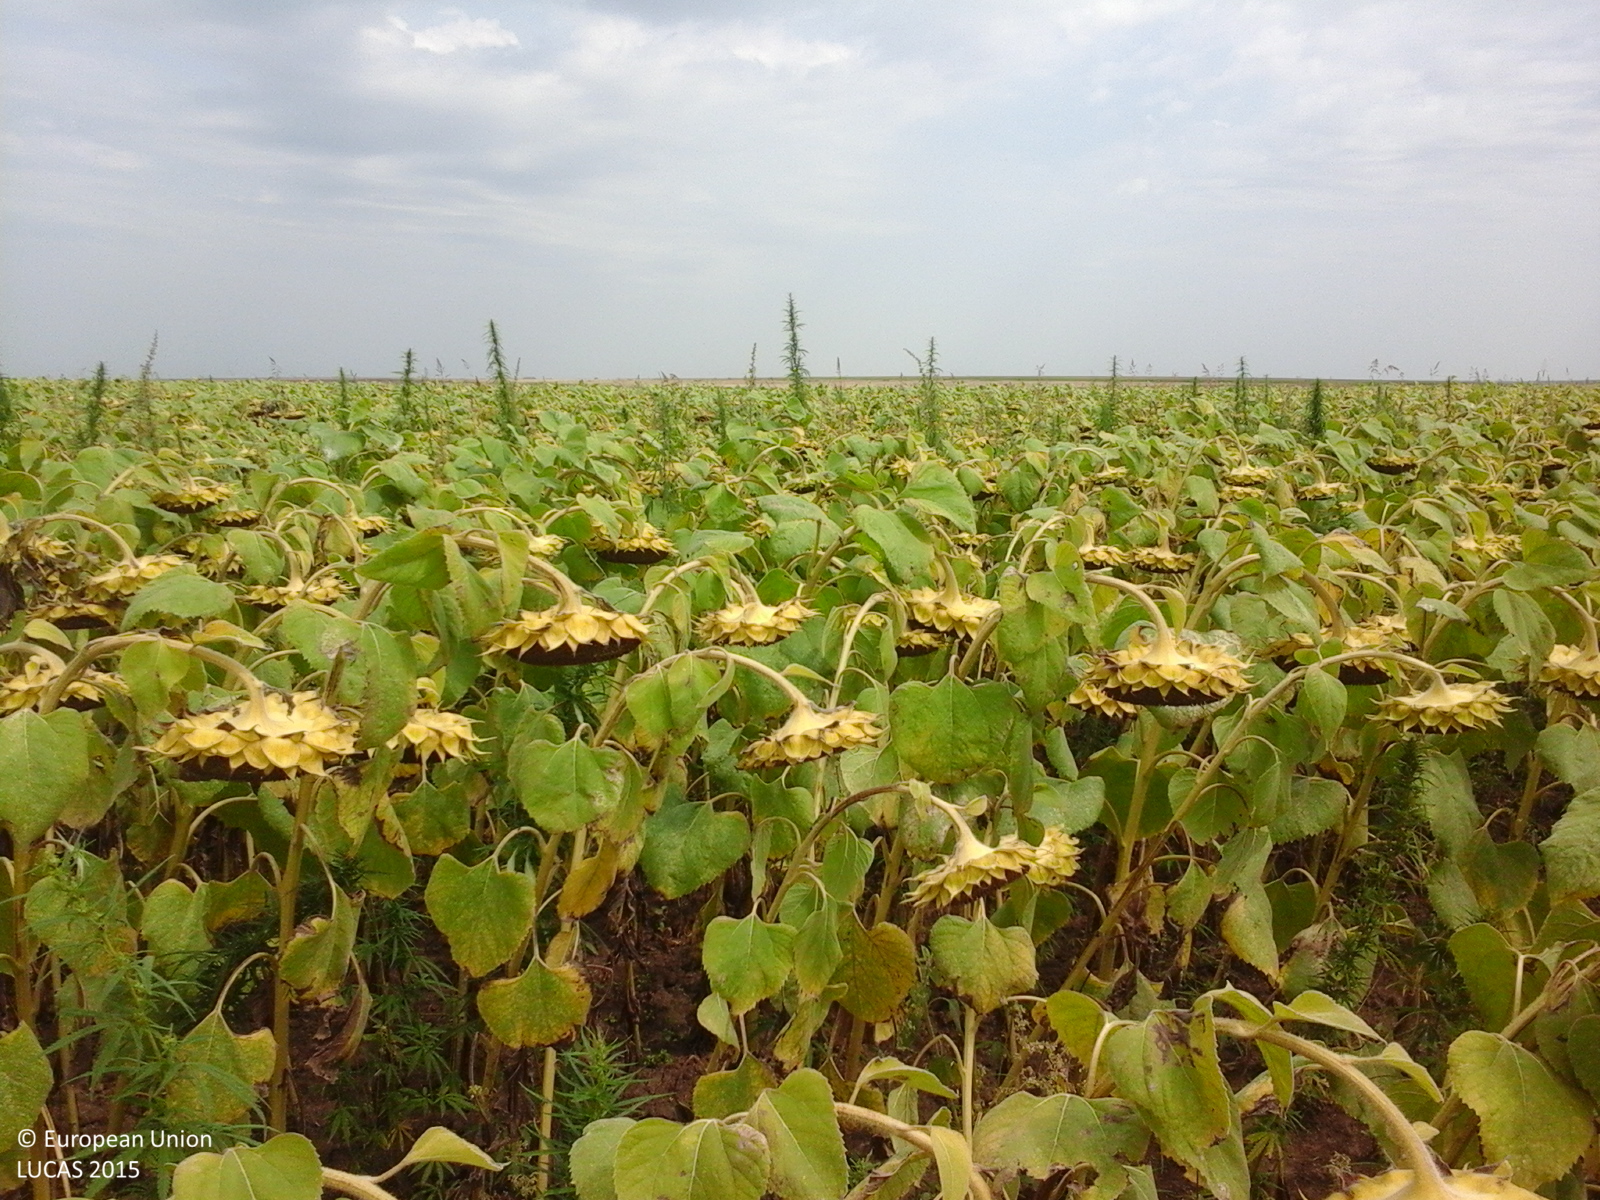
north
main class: Cropland
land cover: Sunflower
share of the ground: > 75 %
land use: Agriculture (excluding fallow land and kitchen gardens)
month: August
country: RO
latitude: 43.8444
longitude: 28.0247
